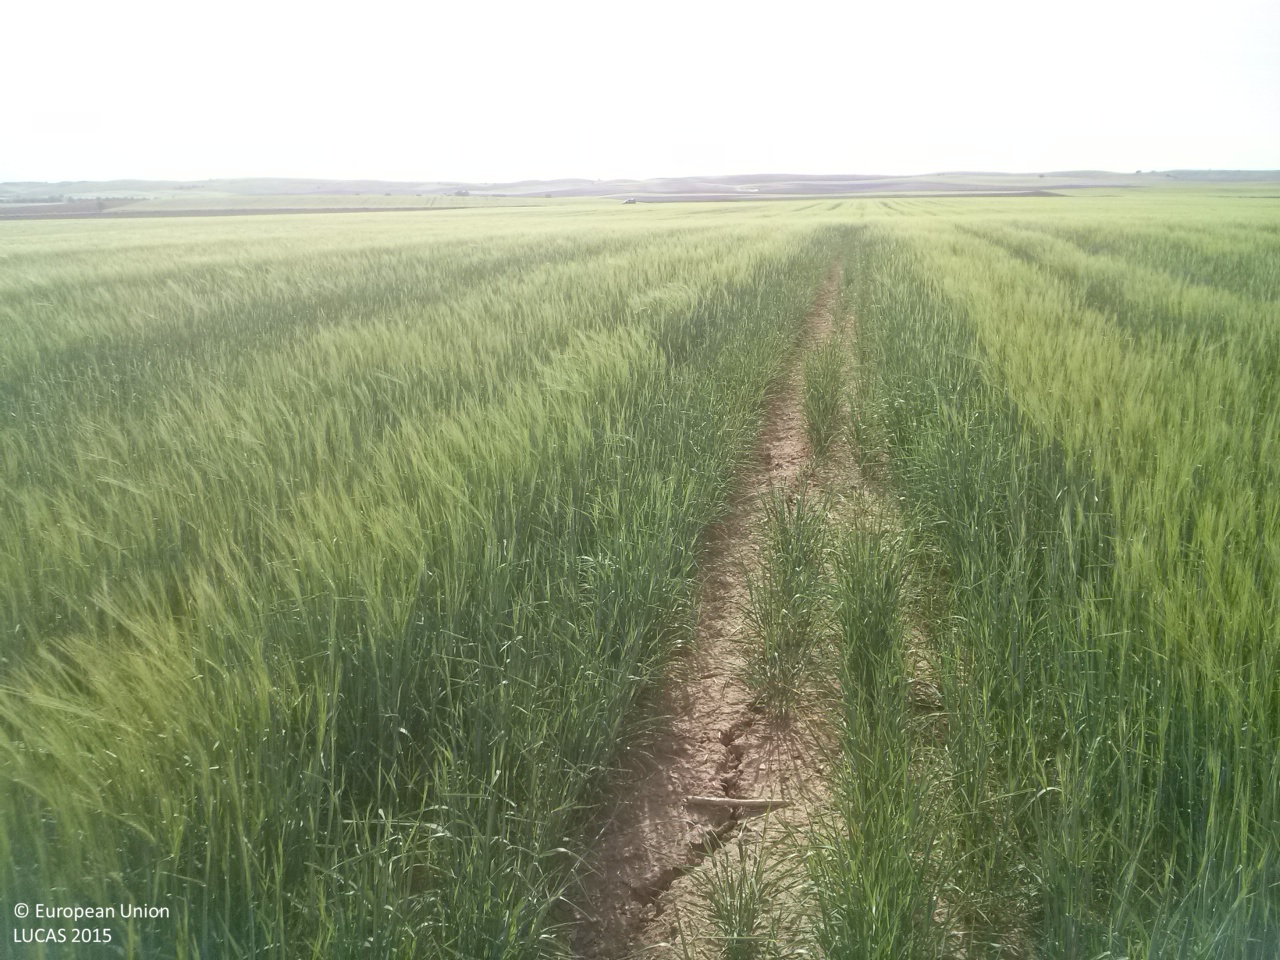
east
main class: Cropland
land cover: Barley
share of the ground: > 75 %
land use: Agriculture (excluding fallow land and kitchen gardens)
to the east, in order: Barley
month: May
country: ES
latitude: 39.8471
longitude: -2.6519
